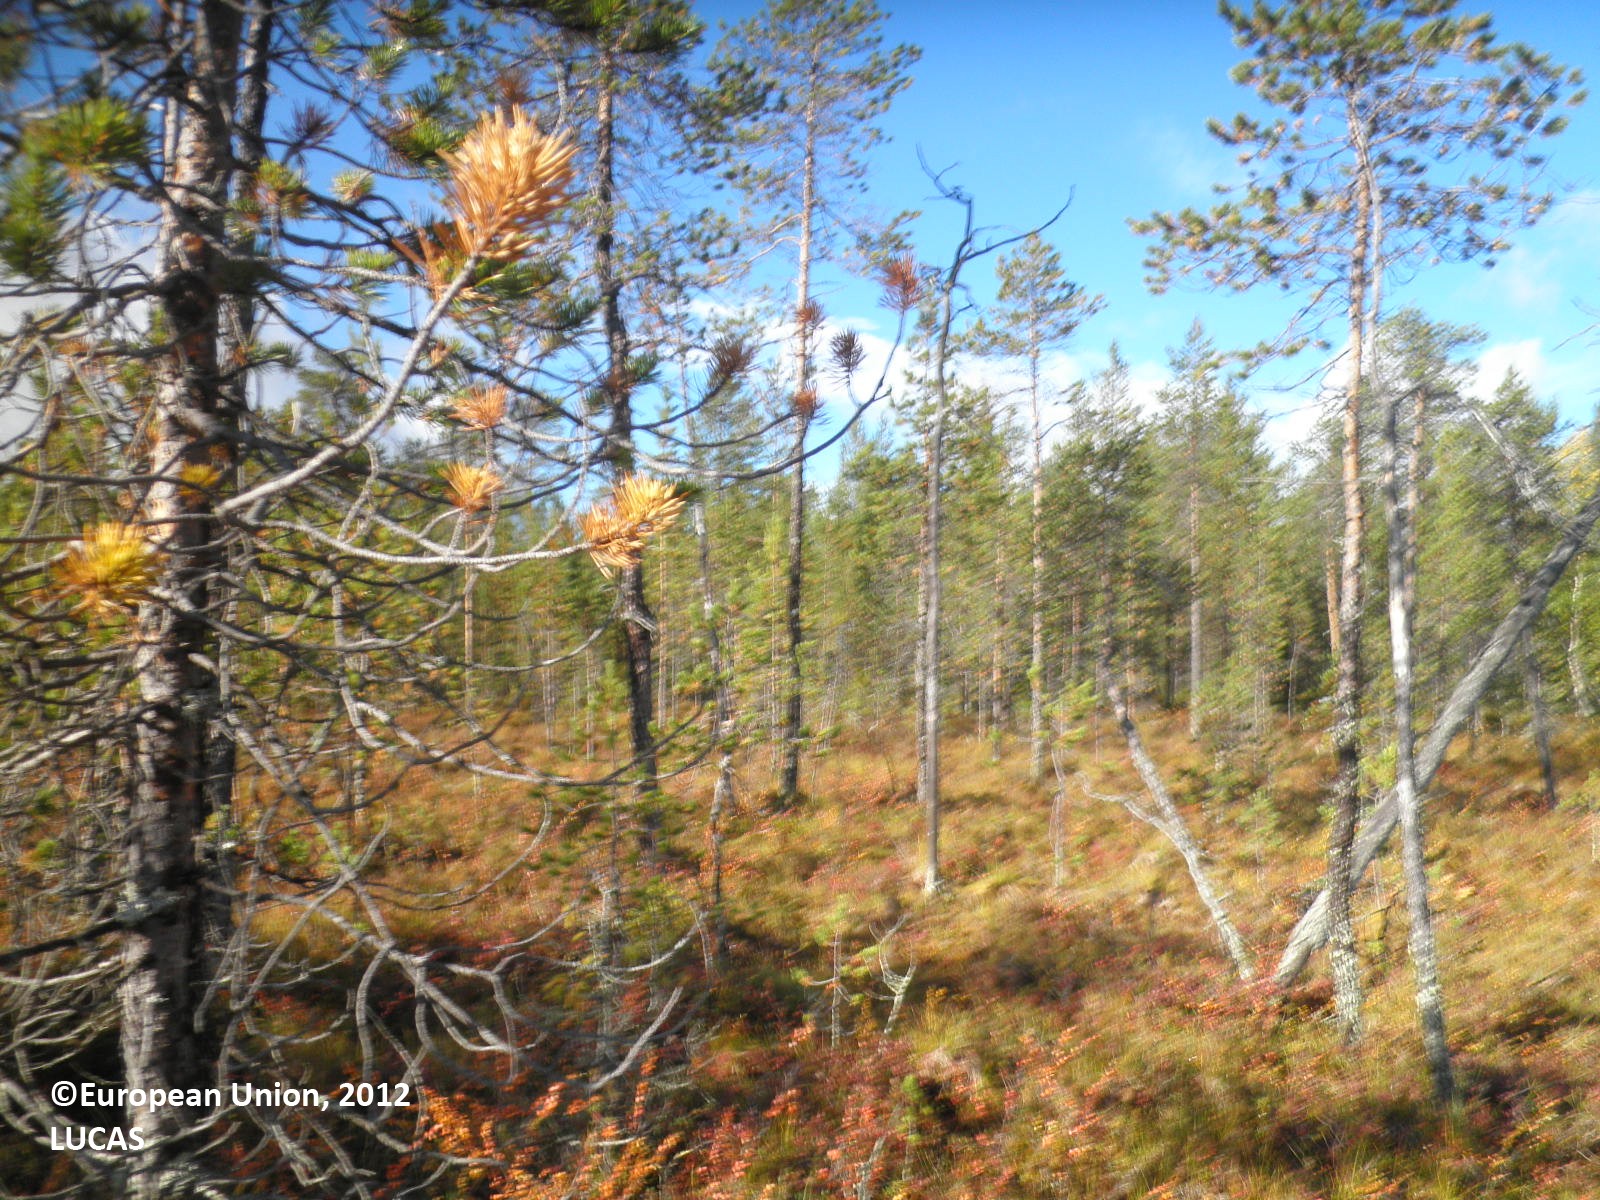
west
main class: Woodland
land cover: Pine dominated coniferous woodland
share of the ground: 10 - 25 %
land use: Forestry
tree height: > 5 m
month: September
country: FI
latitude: 67.4527
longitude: 28.4738
